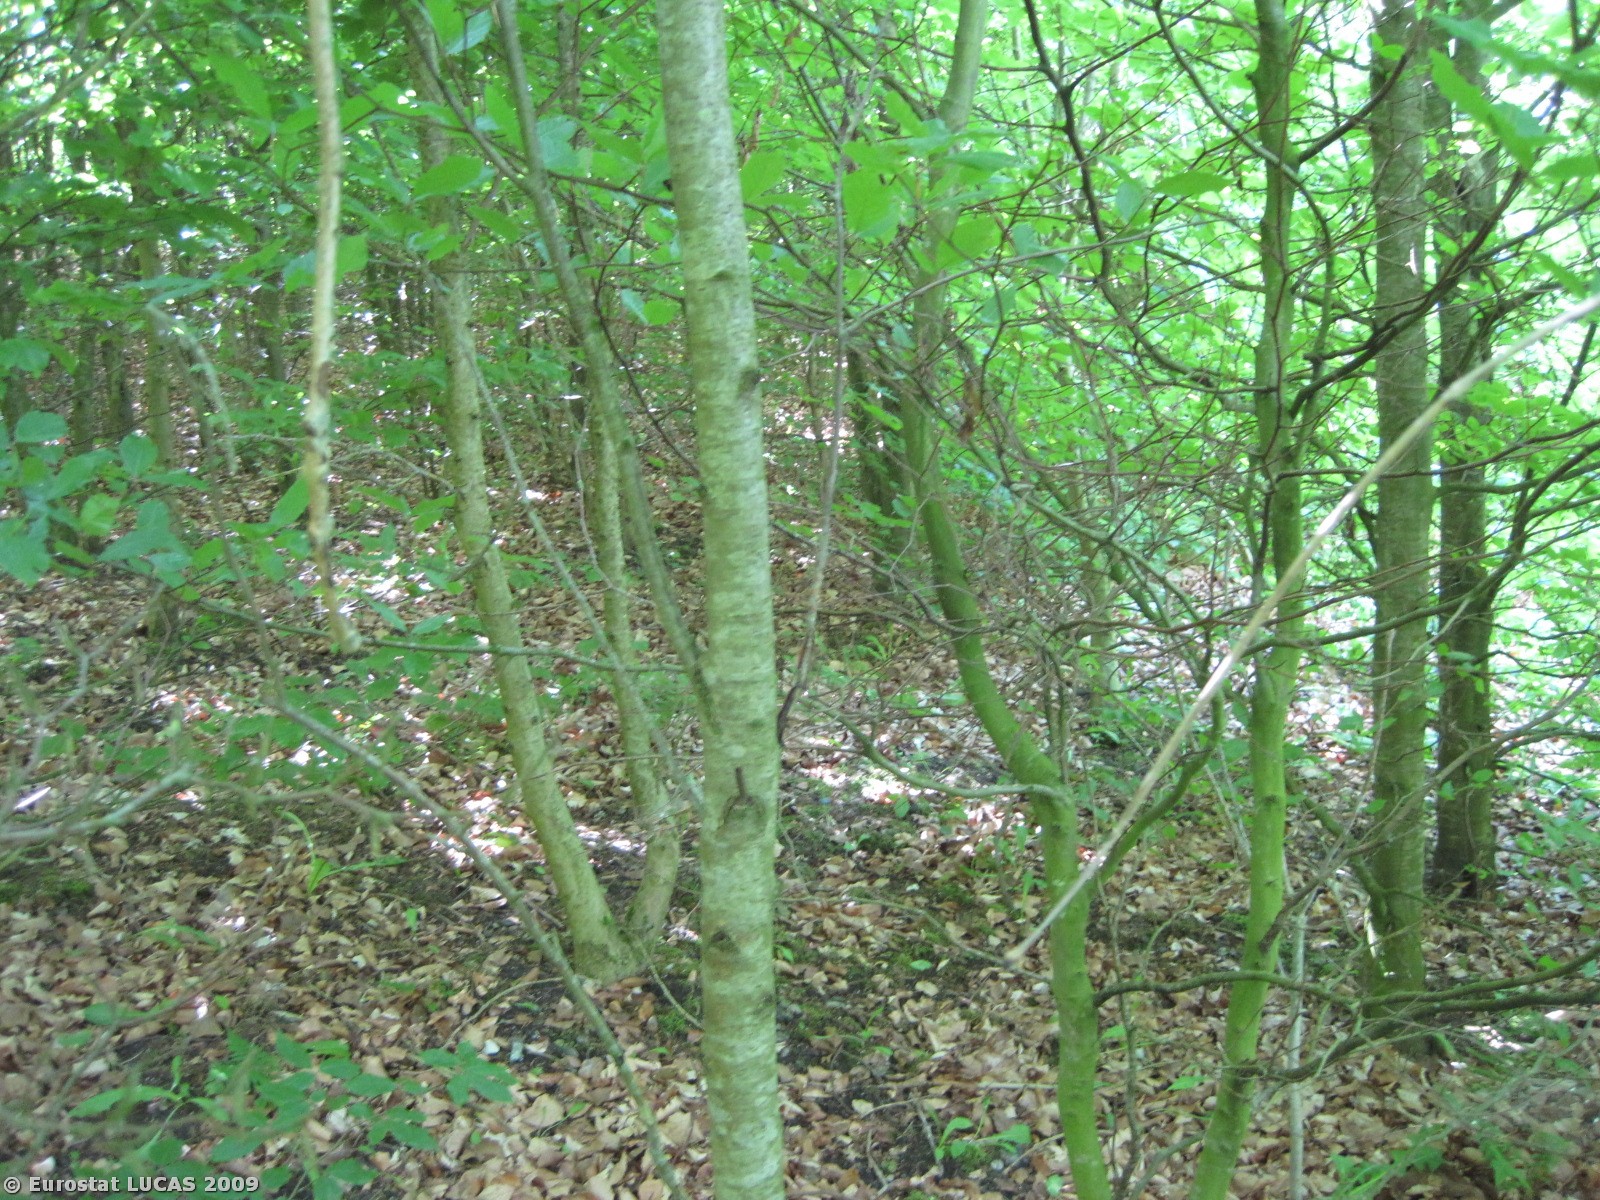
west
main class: Woodland
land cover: Broadleaved woodland
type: beech forest
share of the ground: > 75 %
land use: Forestry
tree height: > 5 m
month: May
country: DK
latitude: 56.5830
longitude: 9.7886
